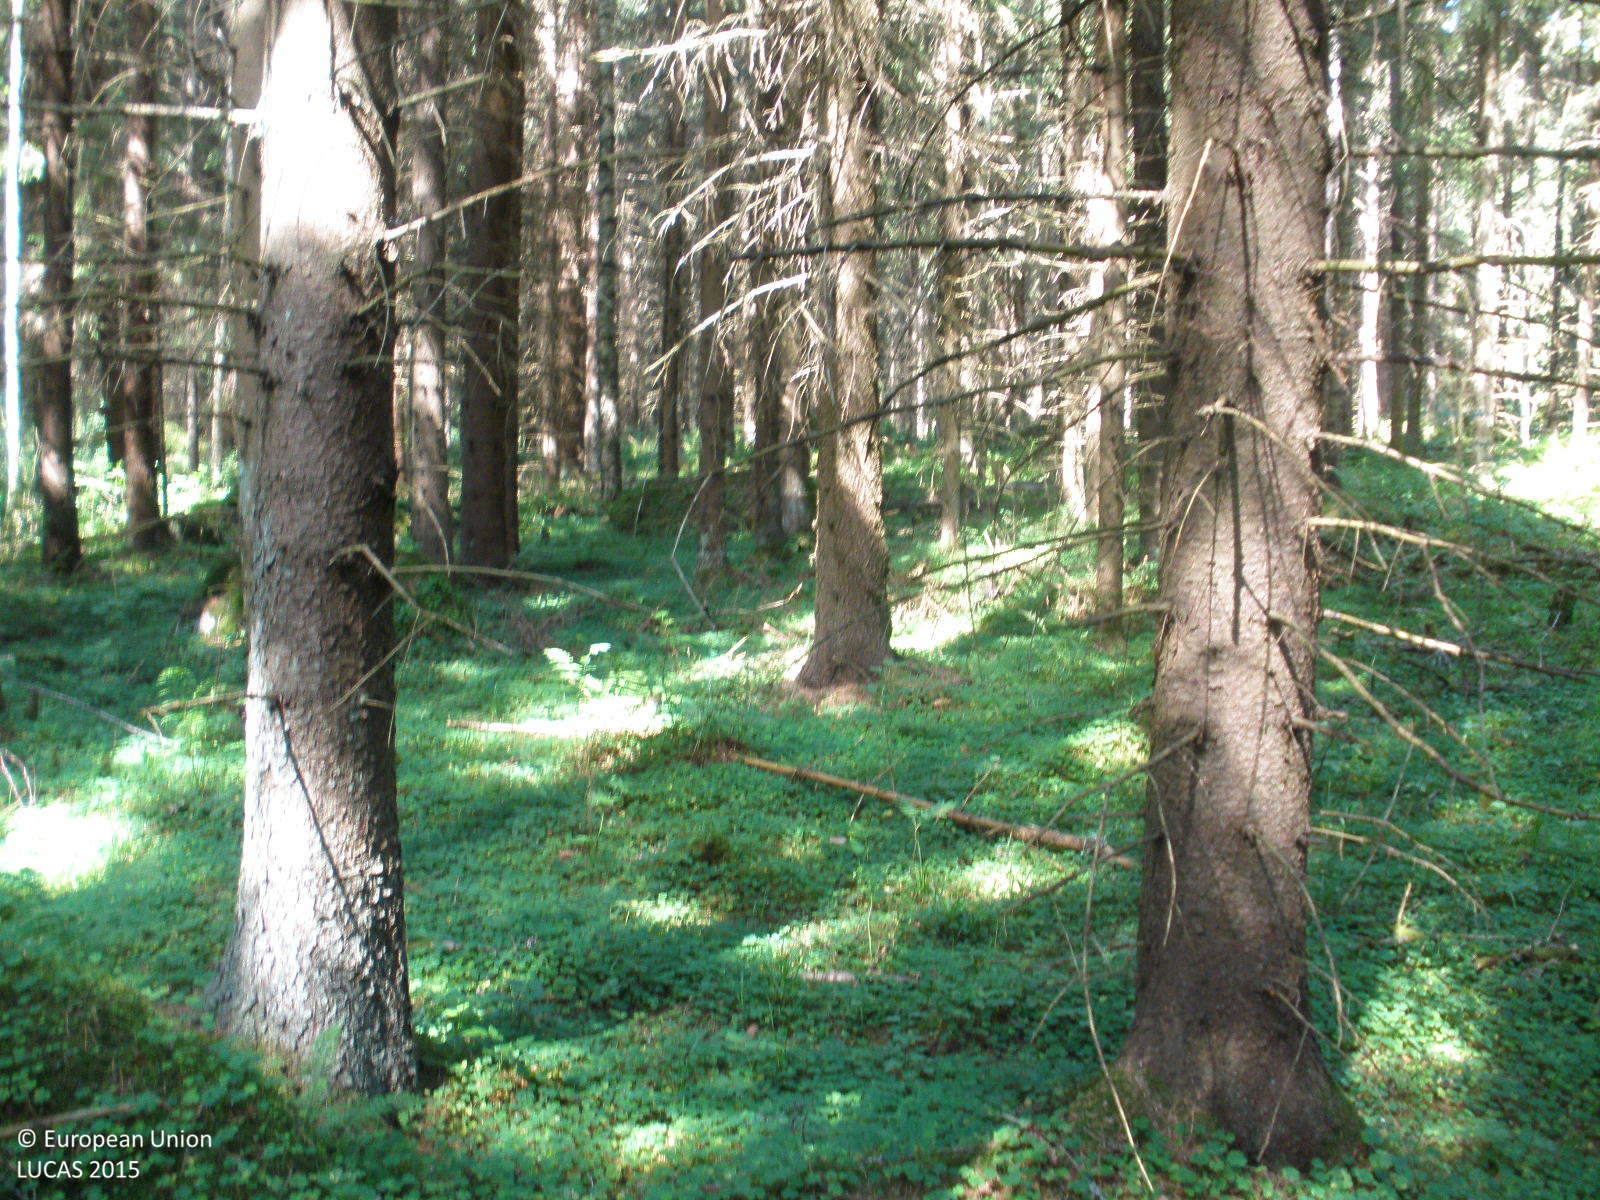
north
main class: Woodland
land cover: Spruce dominated coniferous woodland
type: boreal forest
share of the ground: > 75 %
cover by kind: coniferous forest trees 85 %, lichens and mosses 10 %, herbaceous plants 5 %
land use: Forestry
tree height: > 5 m
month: July
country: FI
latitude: 61.1067
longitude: 24.9351
